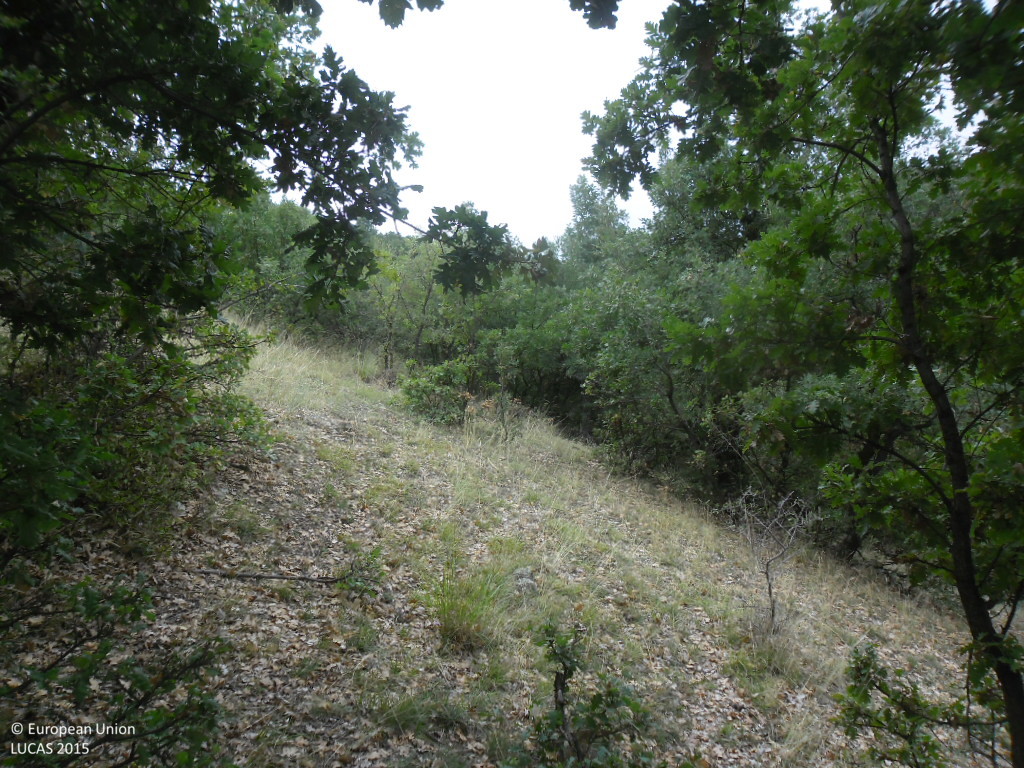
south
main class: Woodland
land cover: Broadleaved woodland
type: thermophilous deciduous forest
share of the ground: > 75 %
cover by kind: broadleaved forest trees 95 %, unconsolidated bare surface 5 %
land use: Forestry
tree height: < 5 m
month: September
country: BG
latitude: 41.6053
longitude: 23.1839
